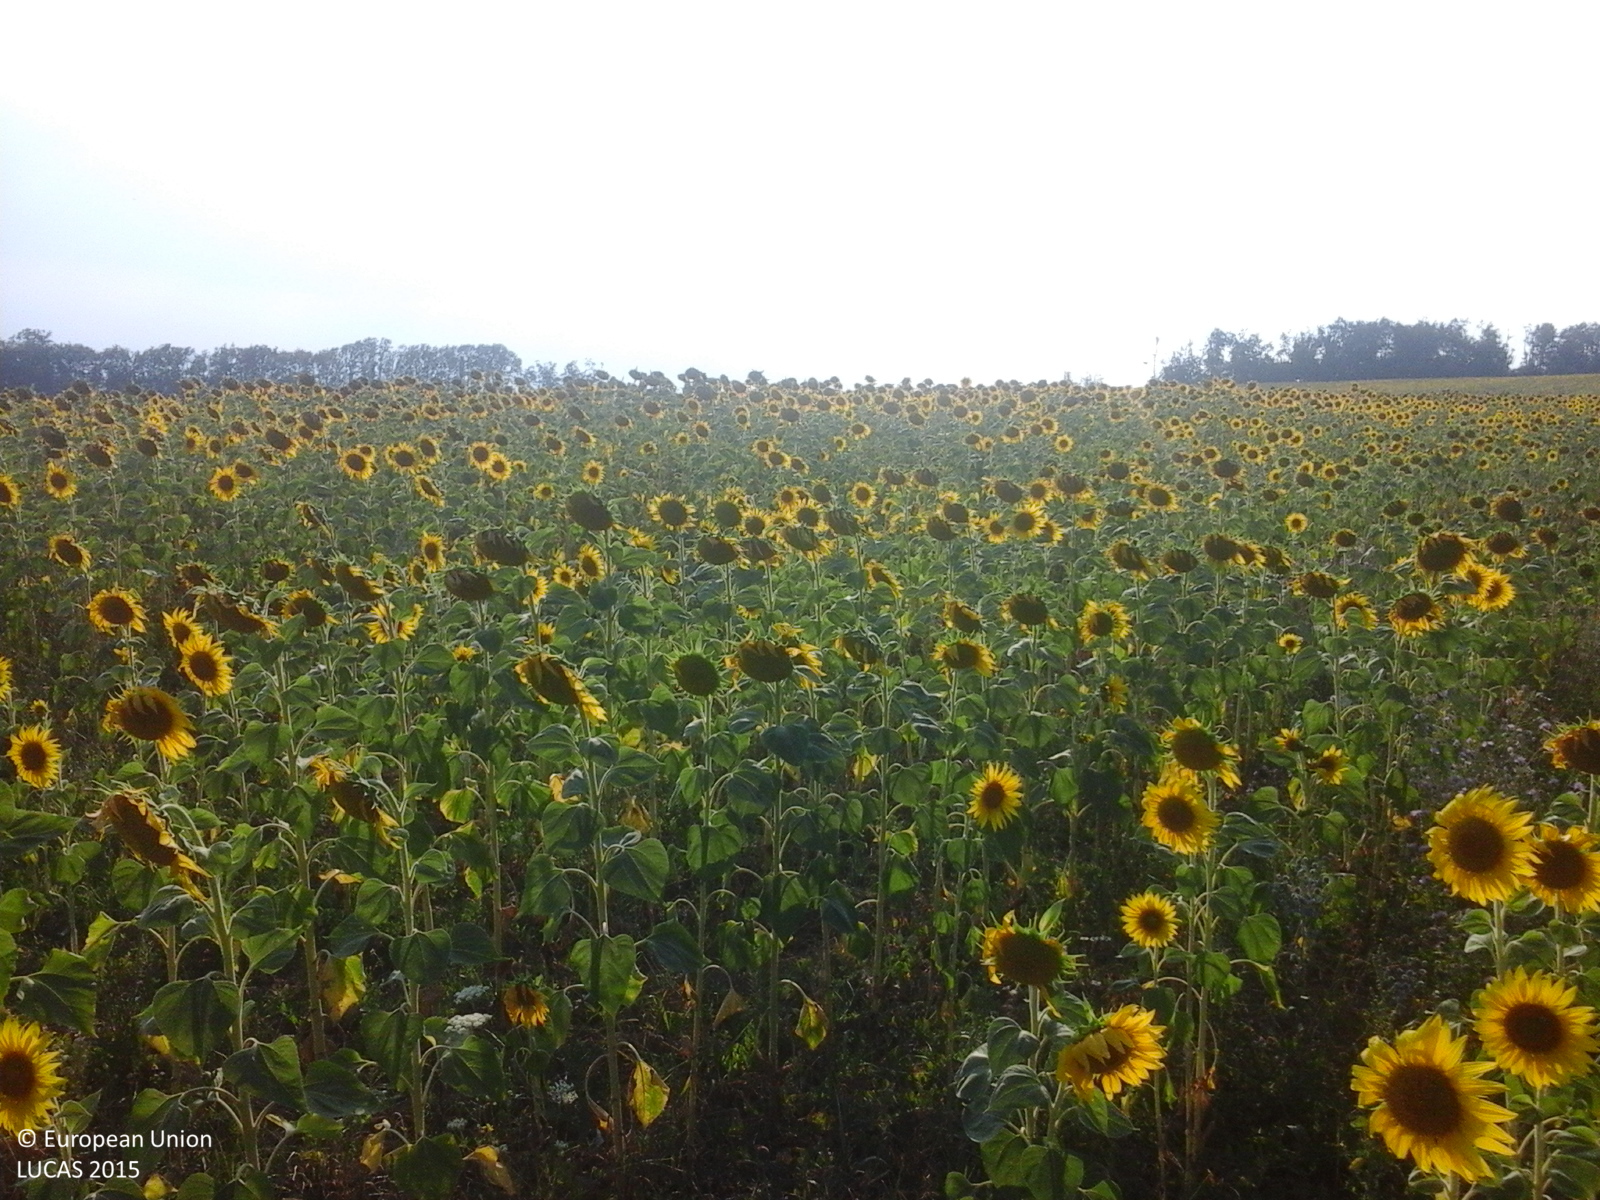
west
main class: Cropland
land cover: Sunflower
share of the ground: 50 - 75 %
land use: Agriculture (excluding fallow land and kitchen gardens)
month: July
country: RO
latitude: 46.4580
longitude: 27.1701
